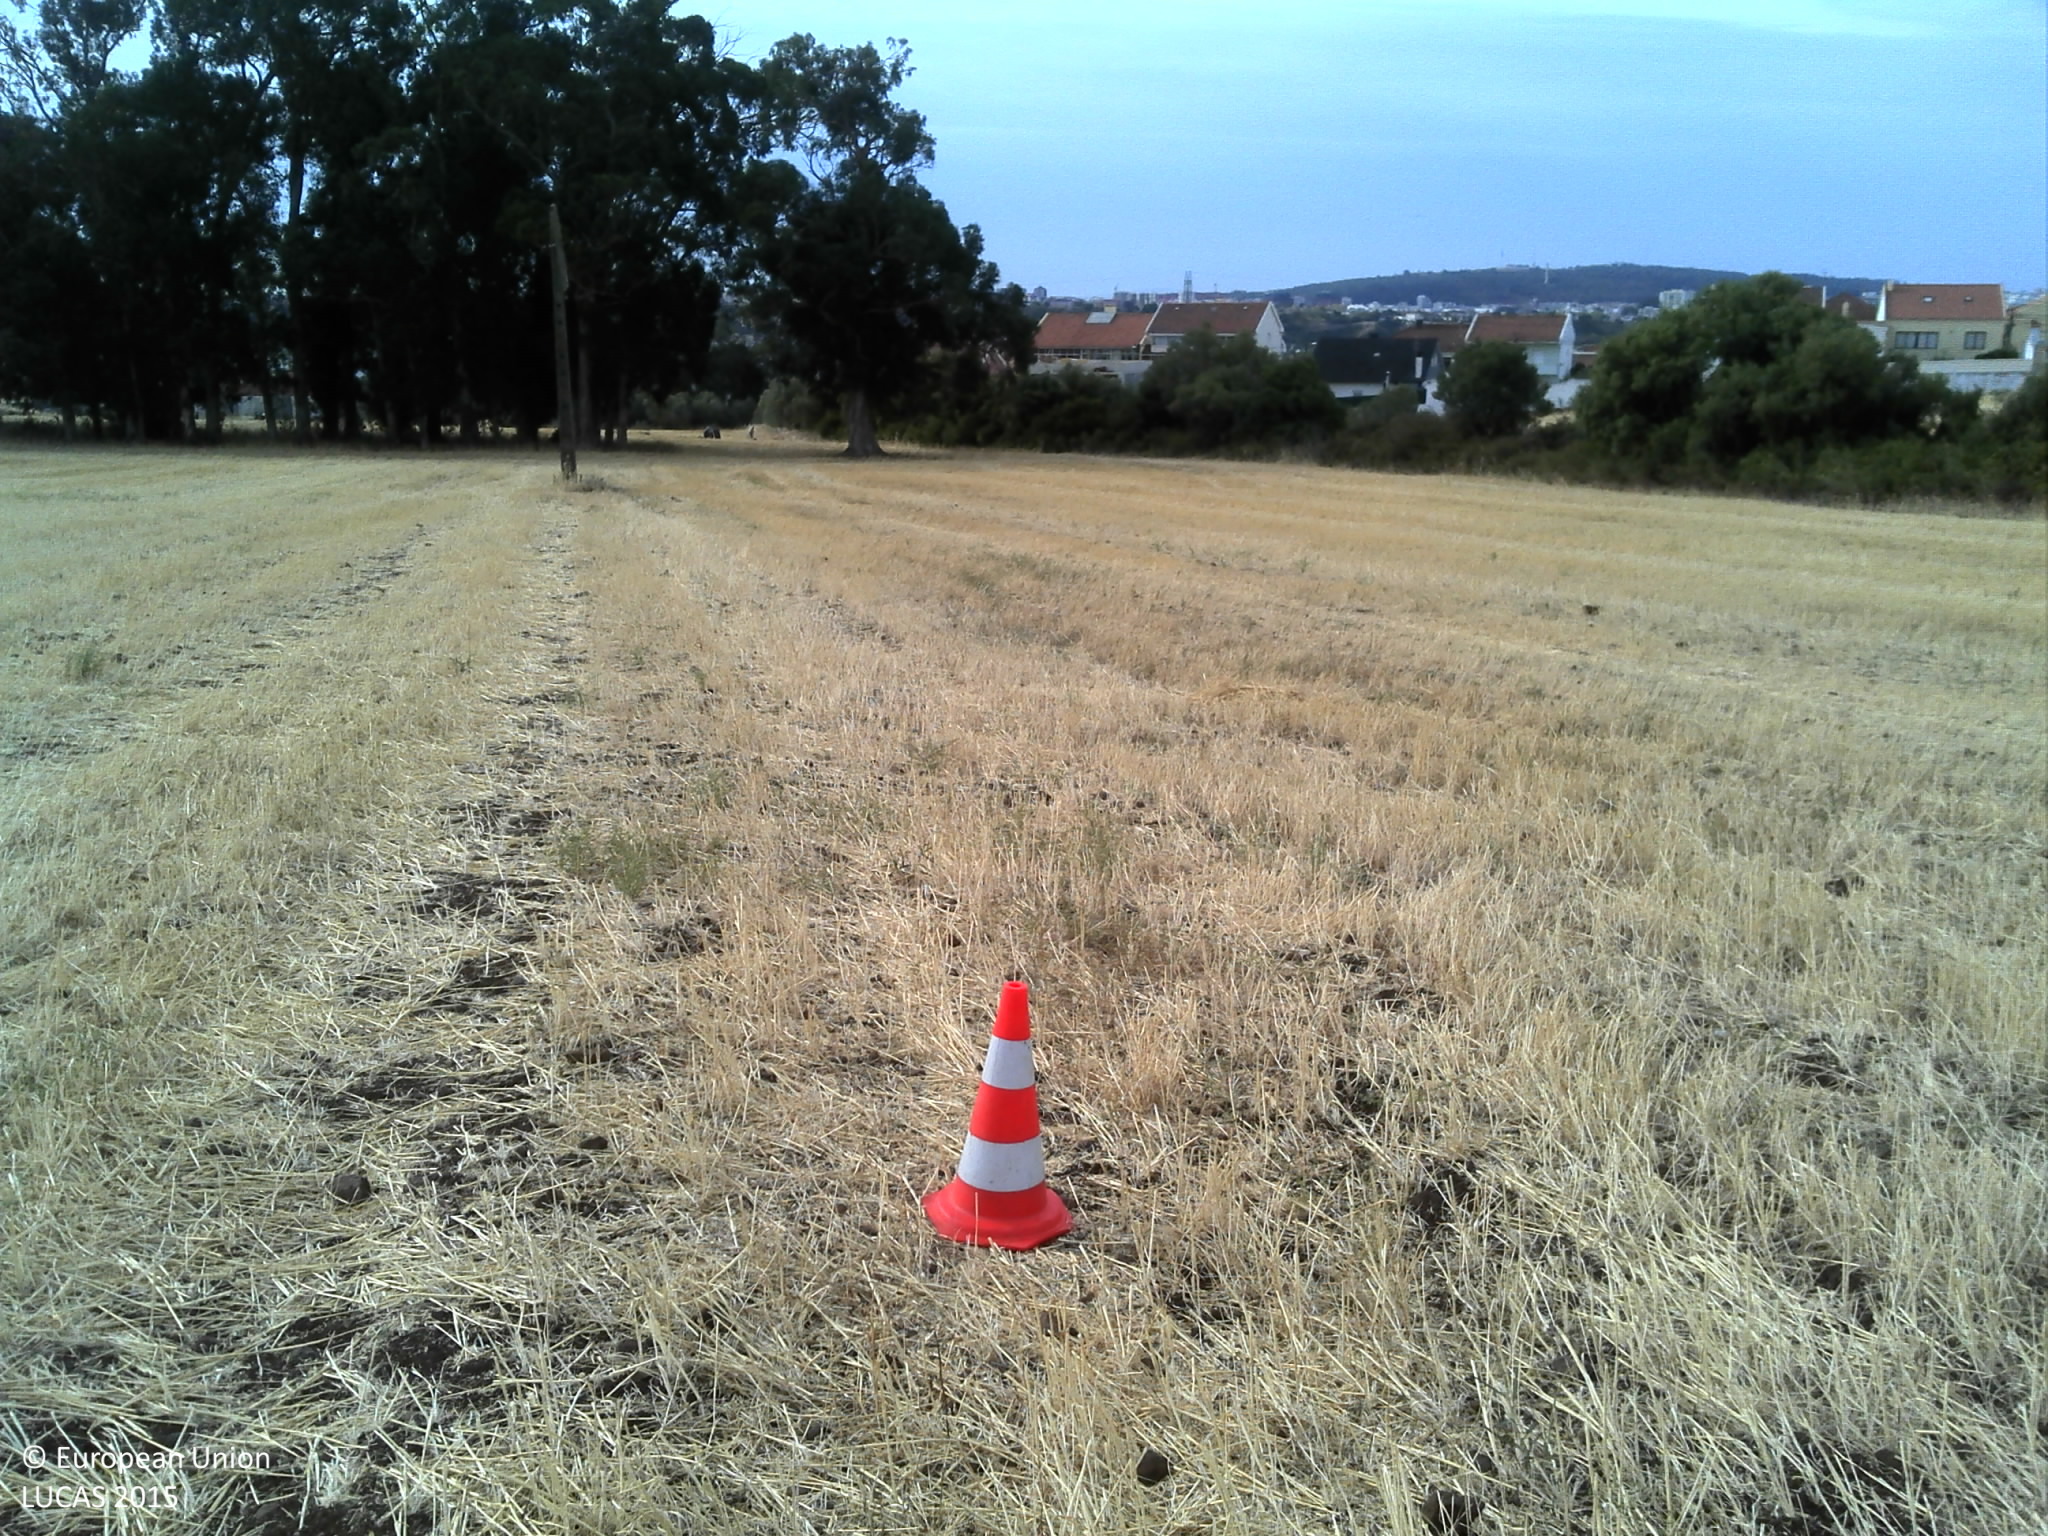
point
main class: Grassland
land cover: Grassland without tree/shrub cover
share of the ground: 25 - 50 %
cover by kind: herbaceous plants 50 %, unconsolidated bare surface 50 %
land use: Agriculture (excluding fallow land and kitchen gardens)
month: August
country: PT
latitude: 38.7951
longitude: -9.2025
